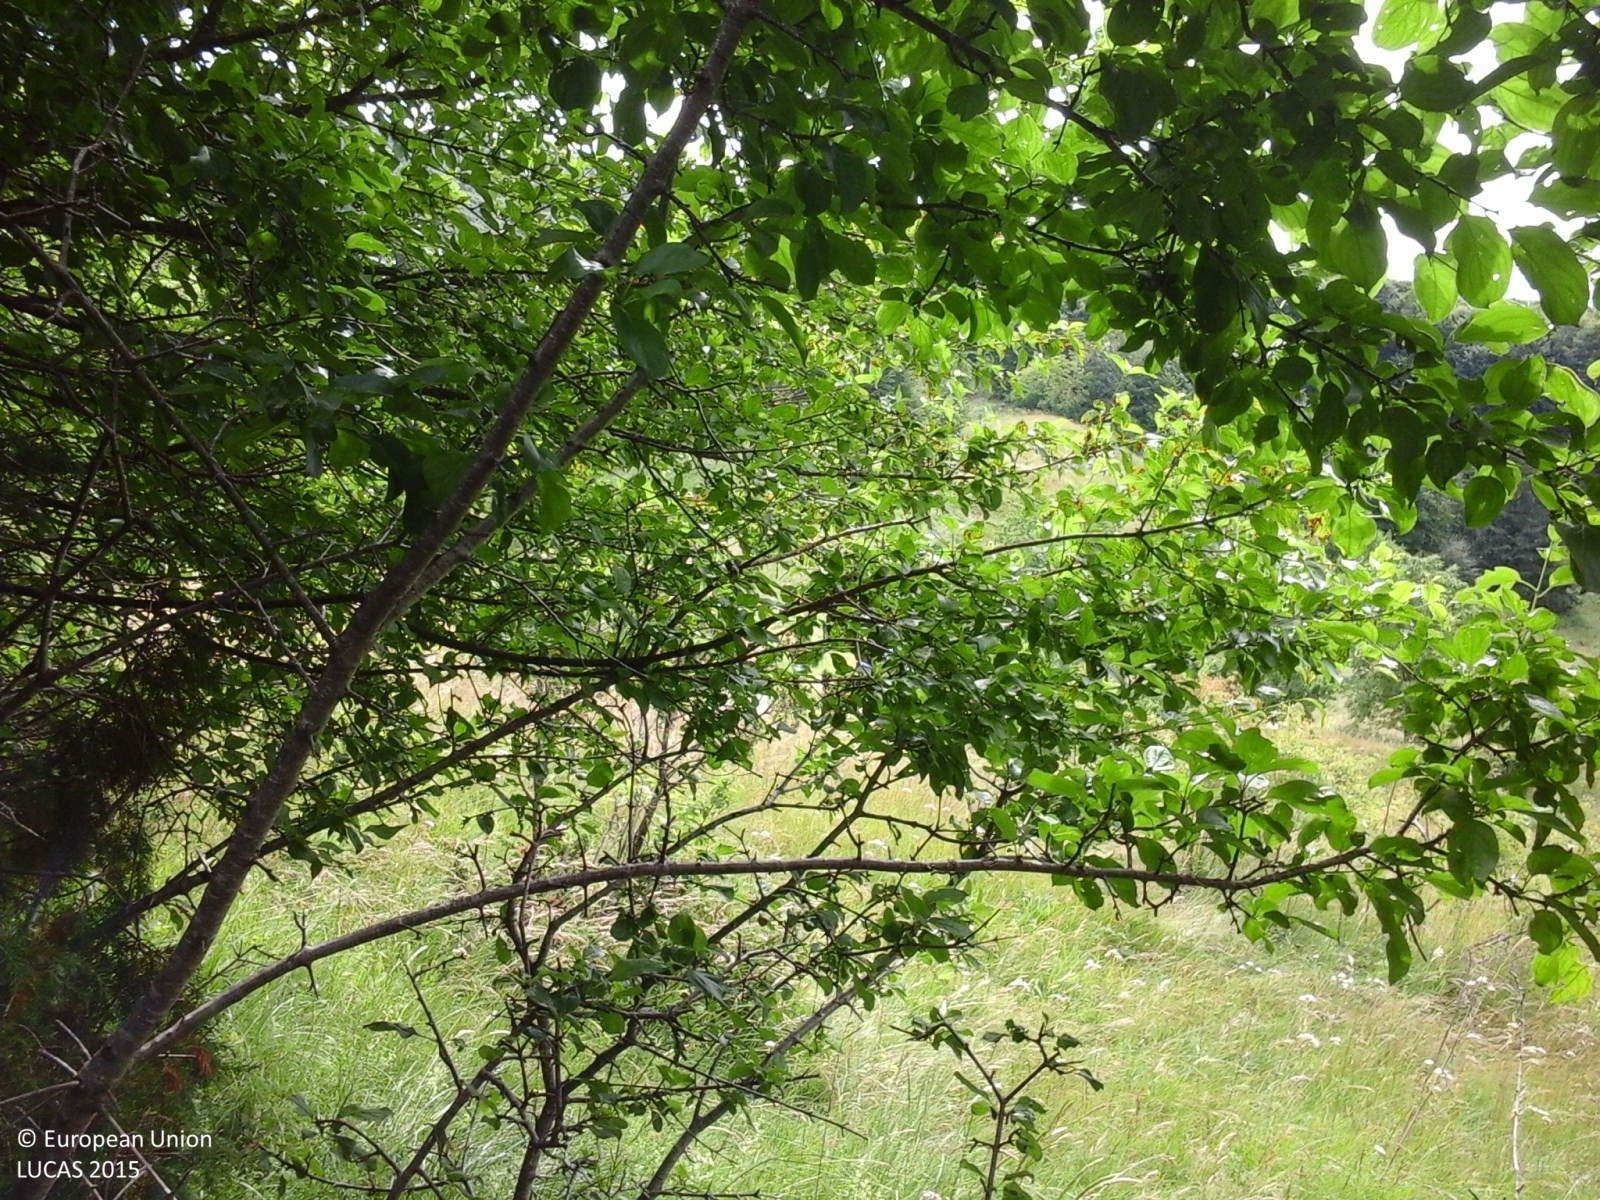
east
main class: Woodland
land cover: Broadleaved woodland
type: mesophytic deciduous forest
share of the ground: > 75 %
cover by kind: broadleaved forest trees 100 %
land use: Semi-natural and natural areas not in use
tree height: > 5 m
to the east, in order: Broadleaved woodland; Grassland with sparse tree/shrub cover; Grassland without tree/shrub cover; Tracks; Grassland with sparse tree/shrub cover; Grassland without tree/shrub cover; Broadleaved woodland
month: June
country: IT
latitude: 46.0177
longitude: 12.4123
